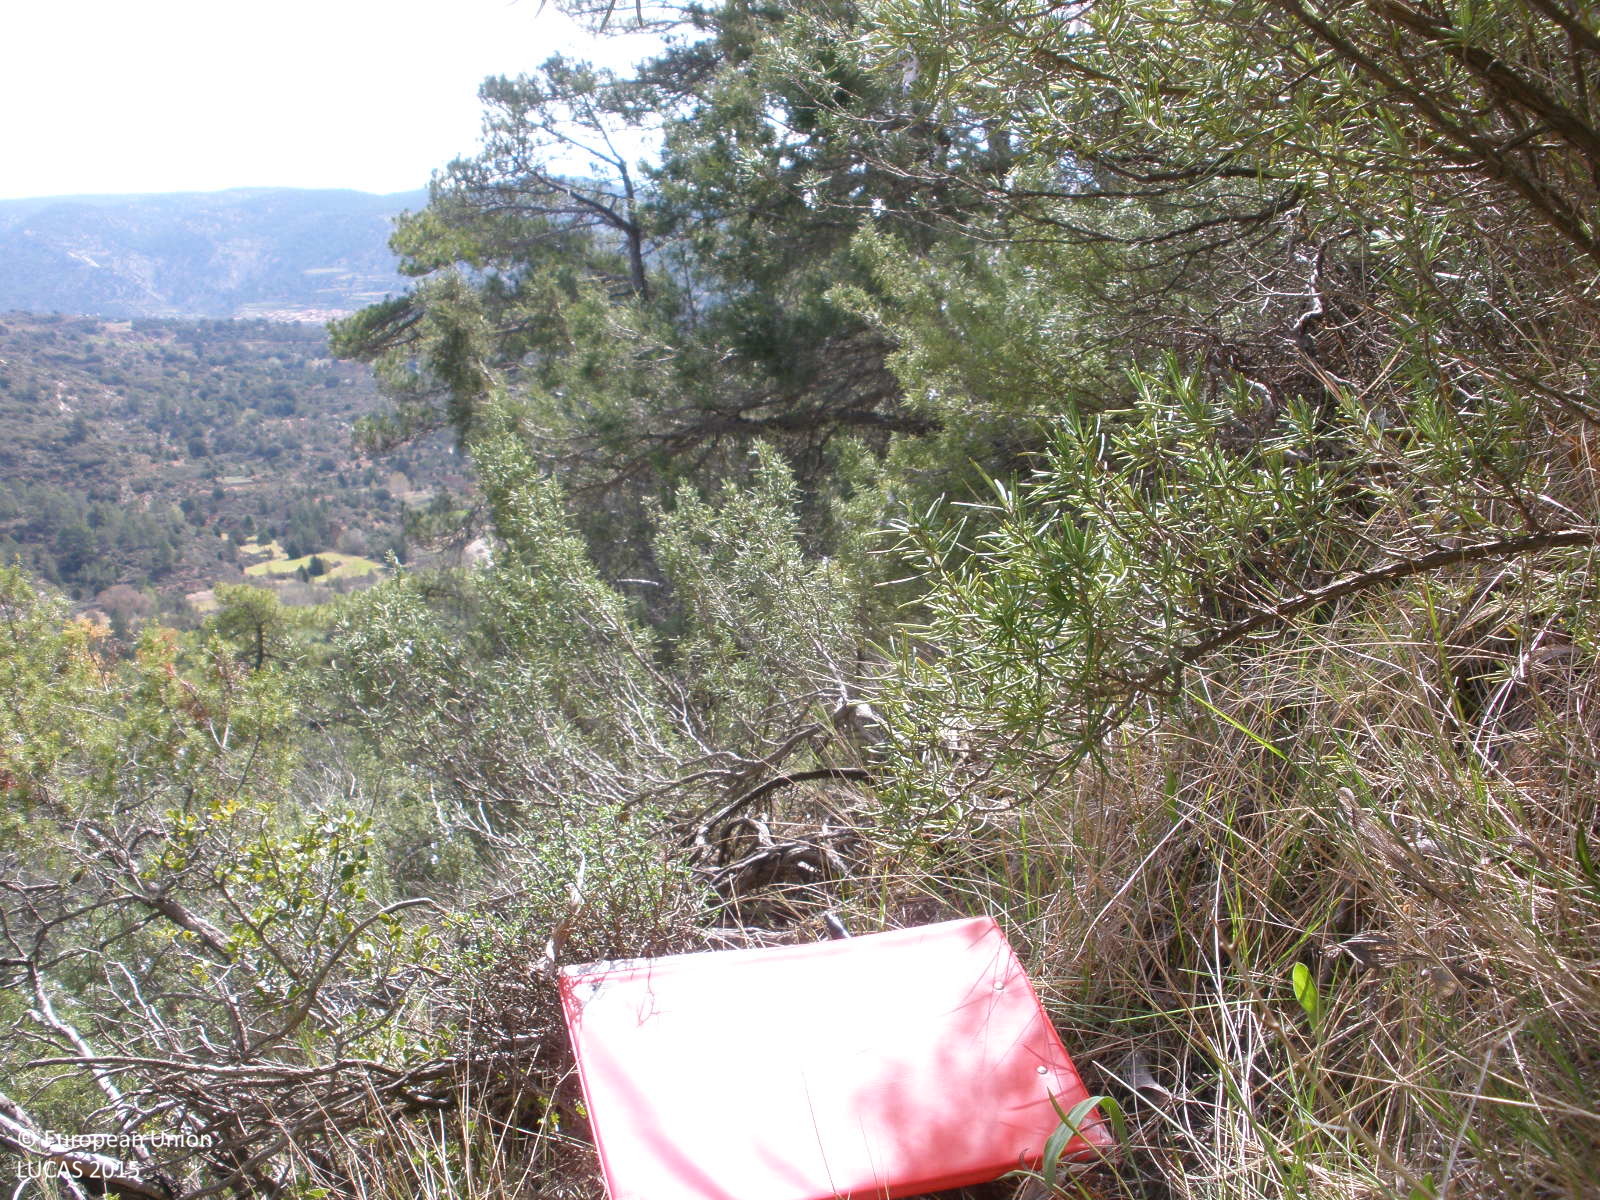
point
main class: Woodland
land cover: Pine dominated coniferous woodland
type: coniferous forest of the mediterranean region
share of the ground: > 75 %
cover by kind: coniferous forest trees 70 %, shrubs 30 %
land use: Semi-natural and natural areas not in use
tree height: > 5 m
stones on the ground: > 50 %
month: April
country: ES
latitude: 40.0461
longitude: -1.1782
